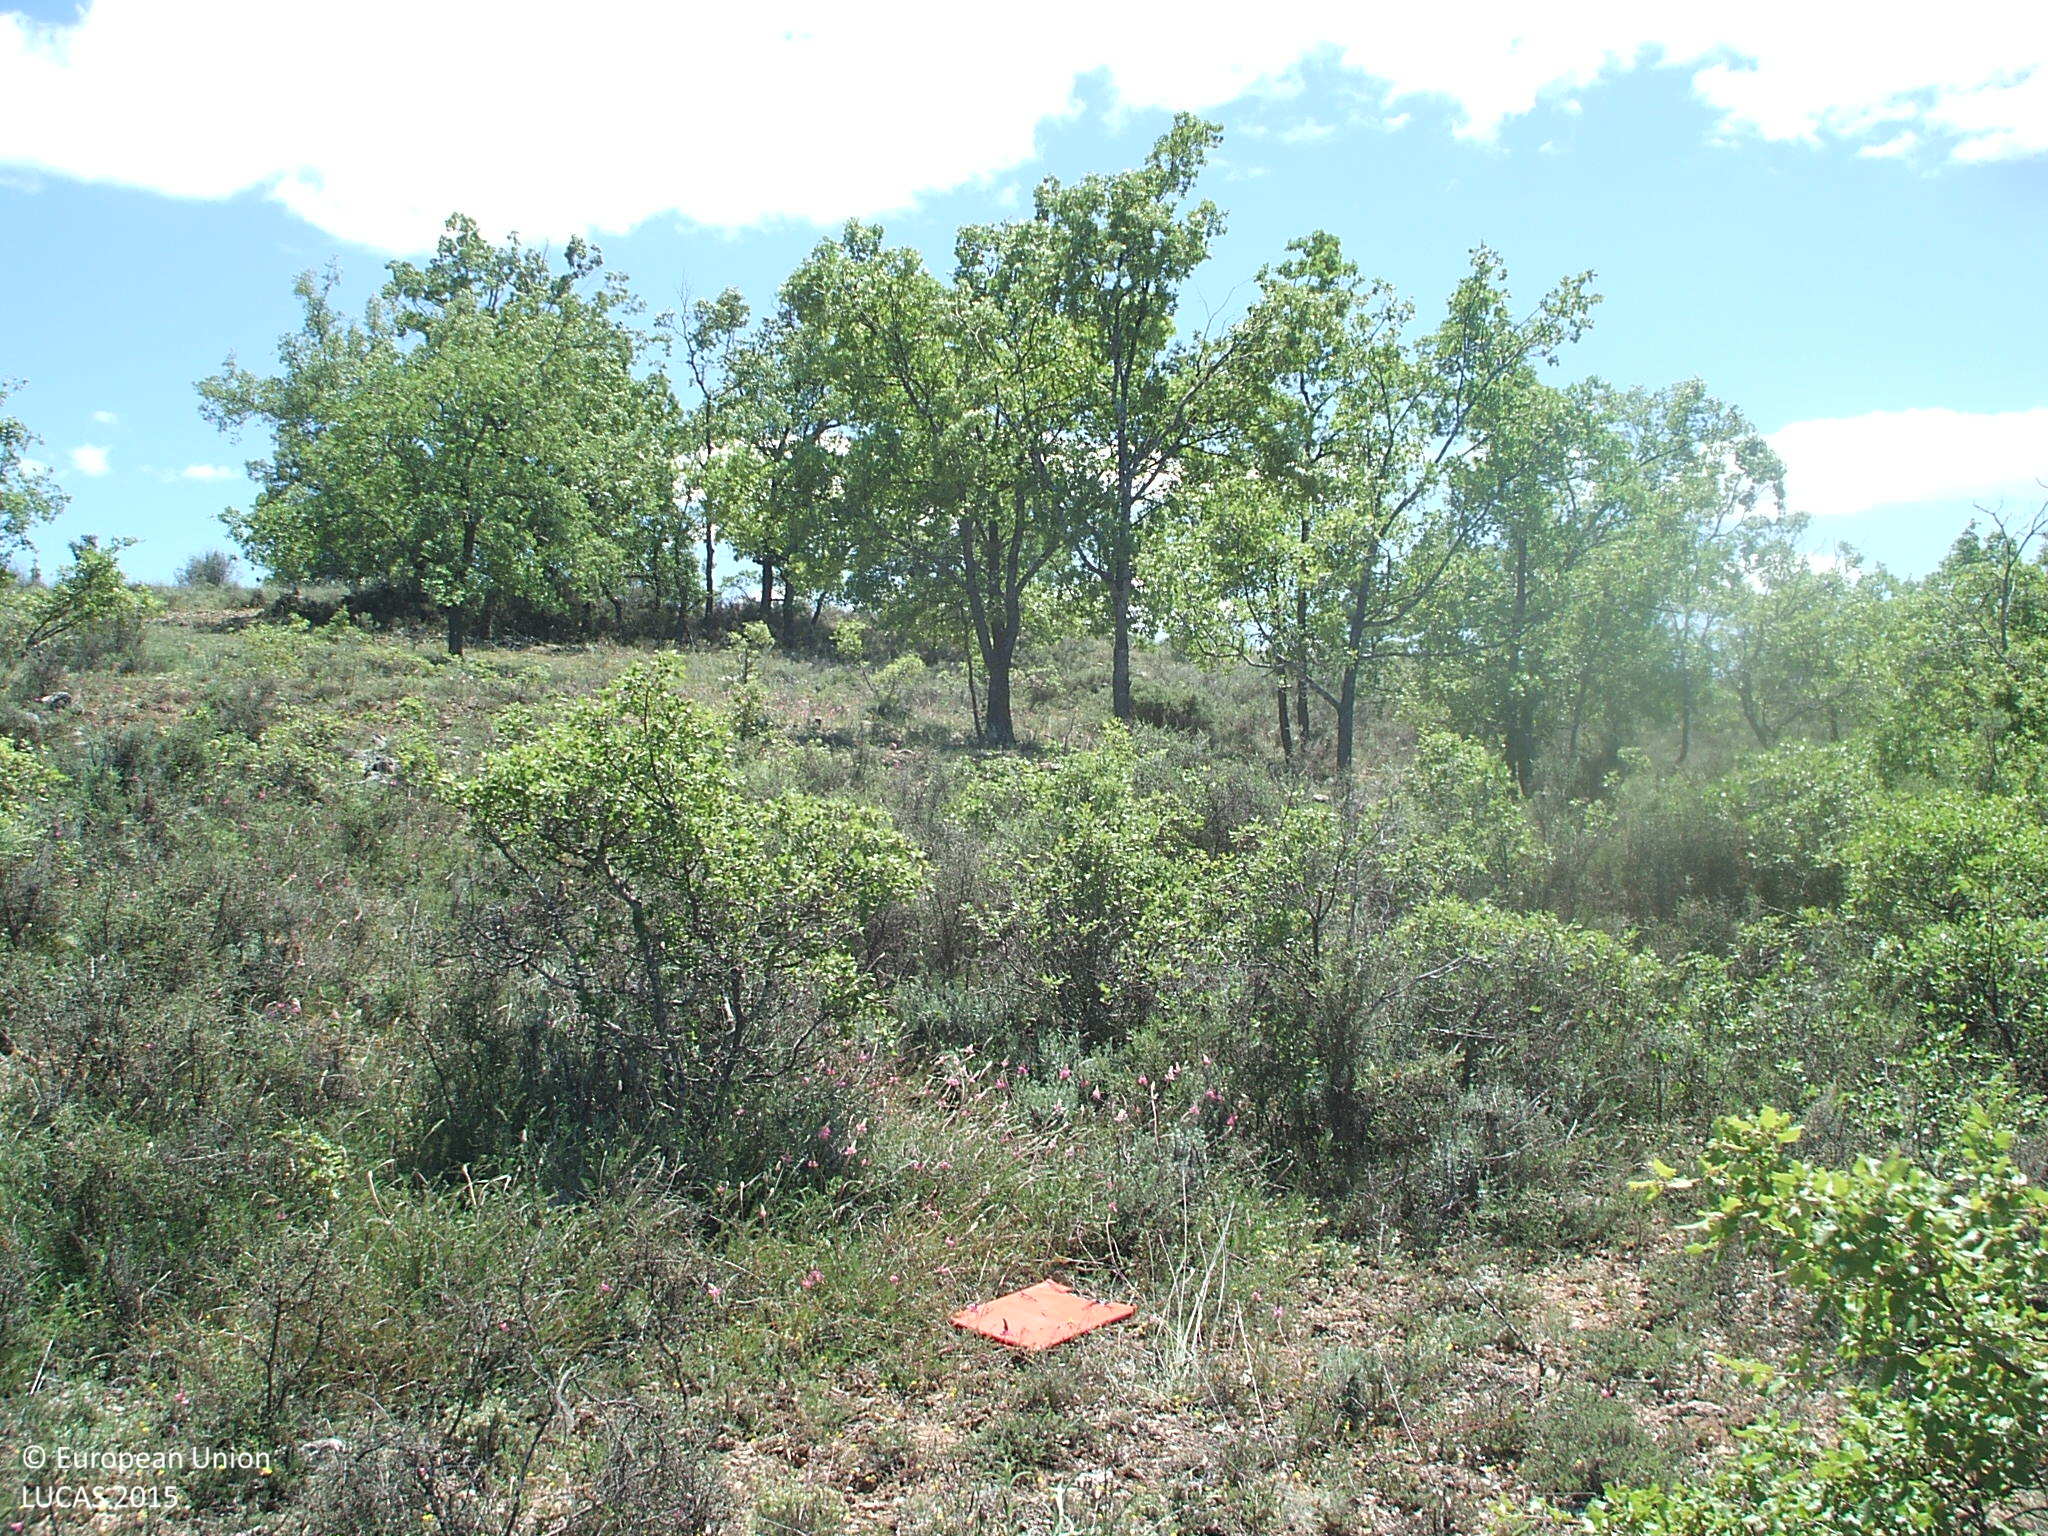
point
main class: Woodland
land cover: Broadleaved woodland
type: broadleaved evergreen forest
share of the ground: 25 - 50 %
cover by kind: broadleaved forest trees 30 %, unconsolidated bare surface 30 %, shrubs 20 %, herbaceous plants 20 %
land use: Semi-natural and natural areas not in use
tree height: > 5 m
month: May
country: ES
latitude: 40.9808
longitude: -2.9300
